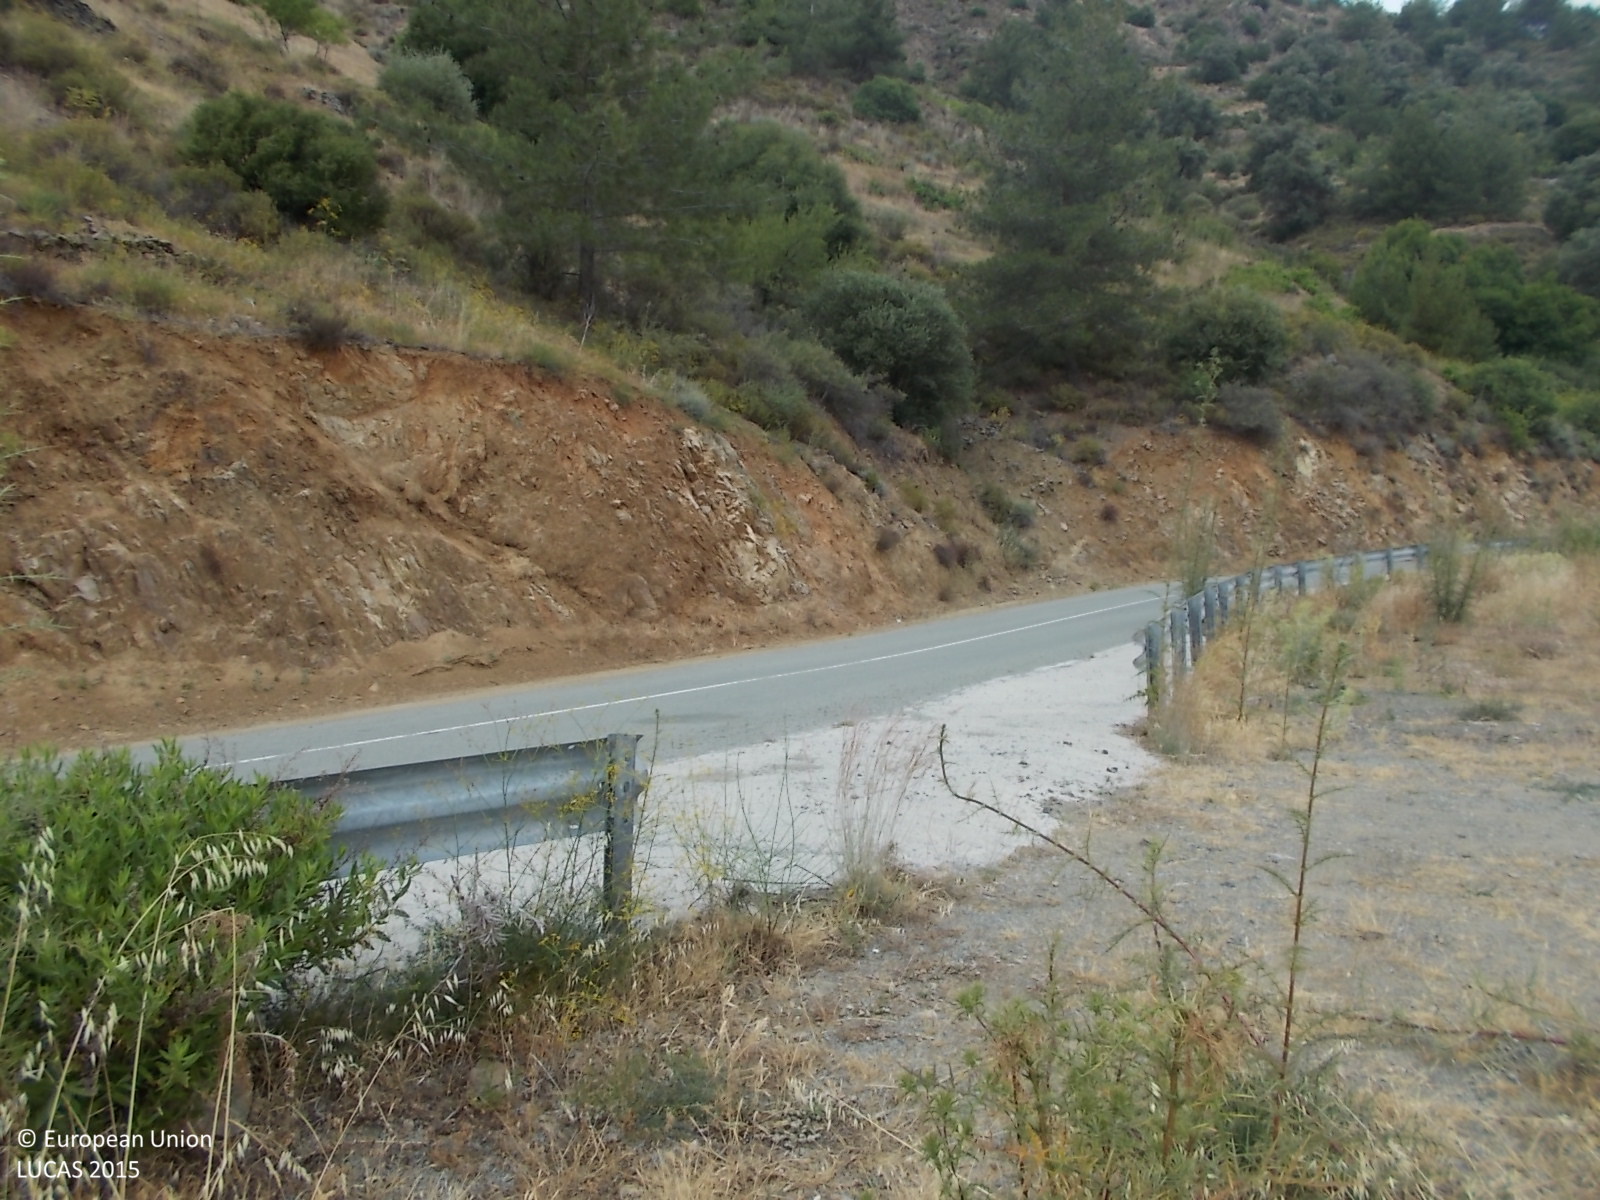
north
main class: Woodland
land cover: Pine dominated coniferous woodland
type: coniferous forest of the mediterranean region
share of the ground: 10 - 25 %
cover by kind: shrubs 35 %, coniferous forest trees 25 %, unconsolidated bare surface 25 %, herbaceous plants 15 %
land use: Forestry
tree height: > 5 m
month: June
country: CY
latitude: 34.9225
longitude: 32.7895
